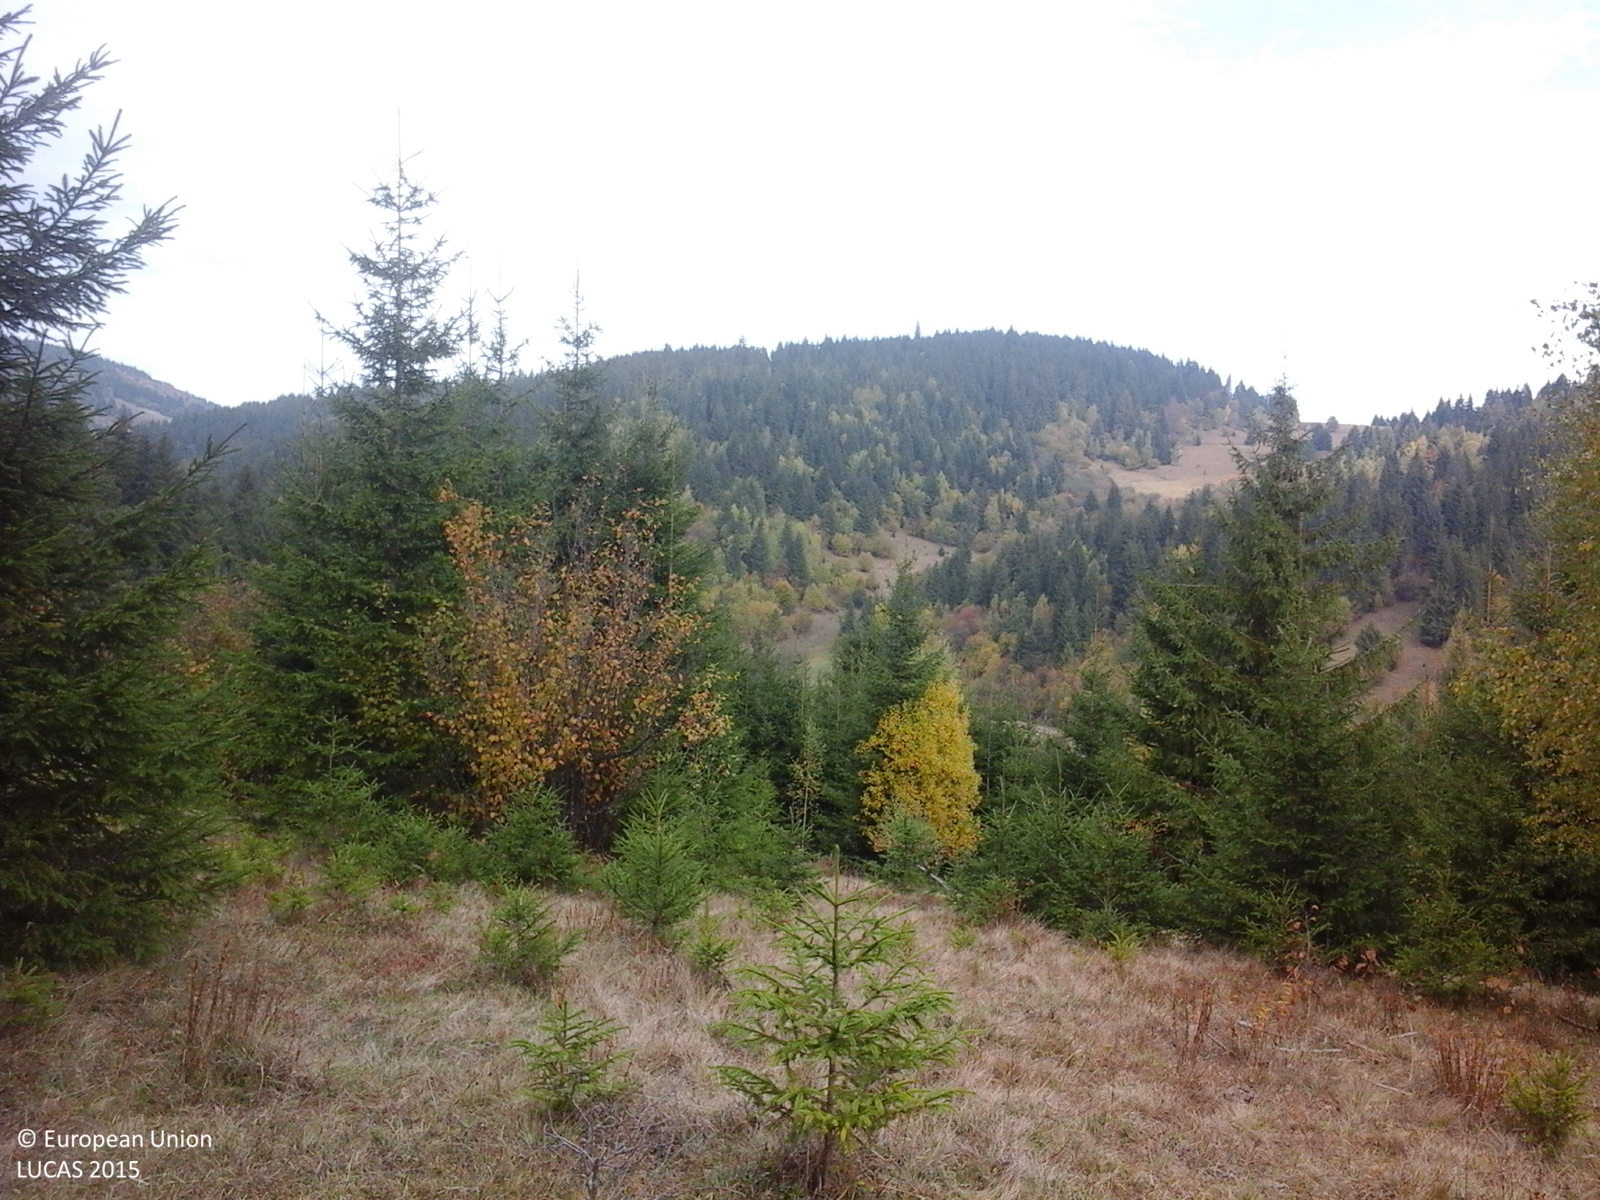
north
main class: Grassland
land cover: Grassland with sparse tree/shrub cover
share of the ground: > 75 %
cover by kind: herbaceous plants 85 %, shrubs 10 %, coniferous forest trees 5 %
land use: Forestry
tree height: < 5 m
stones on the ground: < 10 %
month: October
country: RO
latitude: 46.2896
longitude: 26.0208
